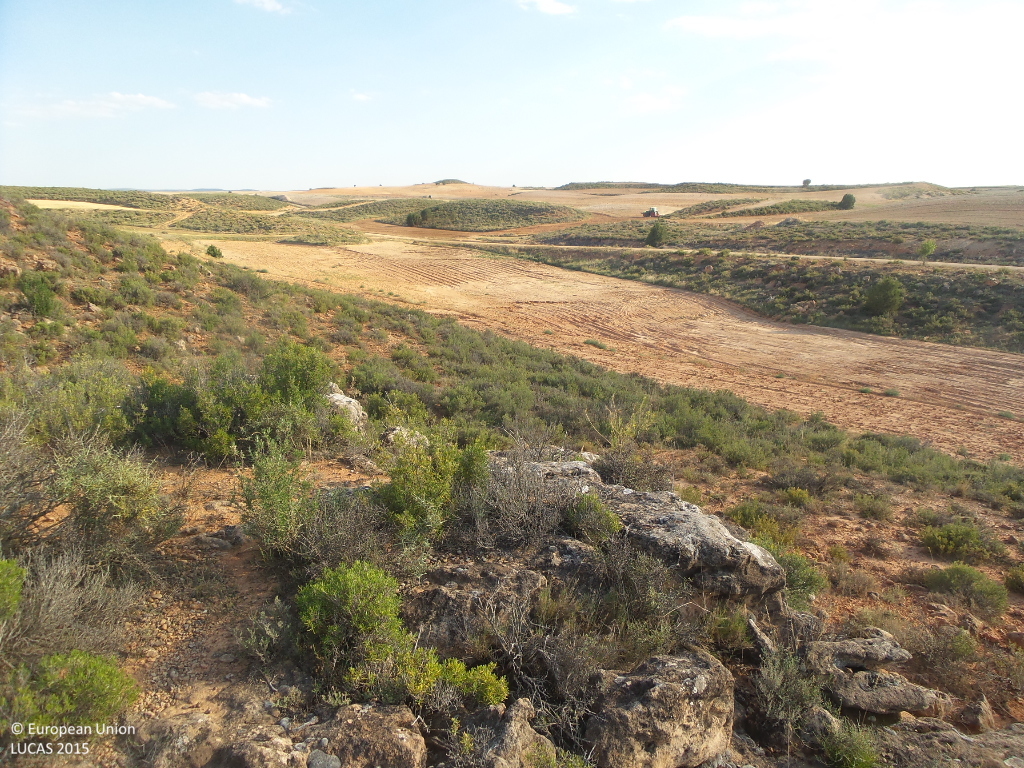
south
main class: Shrubland
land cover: Shrubland without tree cover
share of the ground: 25 - 50 %
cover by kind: shrubs 40 %, unconsolidated bare surface 30 %, consolidated bare surface 25 %, herbaceous plants 5 %
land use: Semi-natural and natural areas not in use
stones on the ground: < 10 %
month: July
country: ES
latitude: 41.2427
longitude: -2.1644
